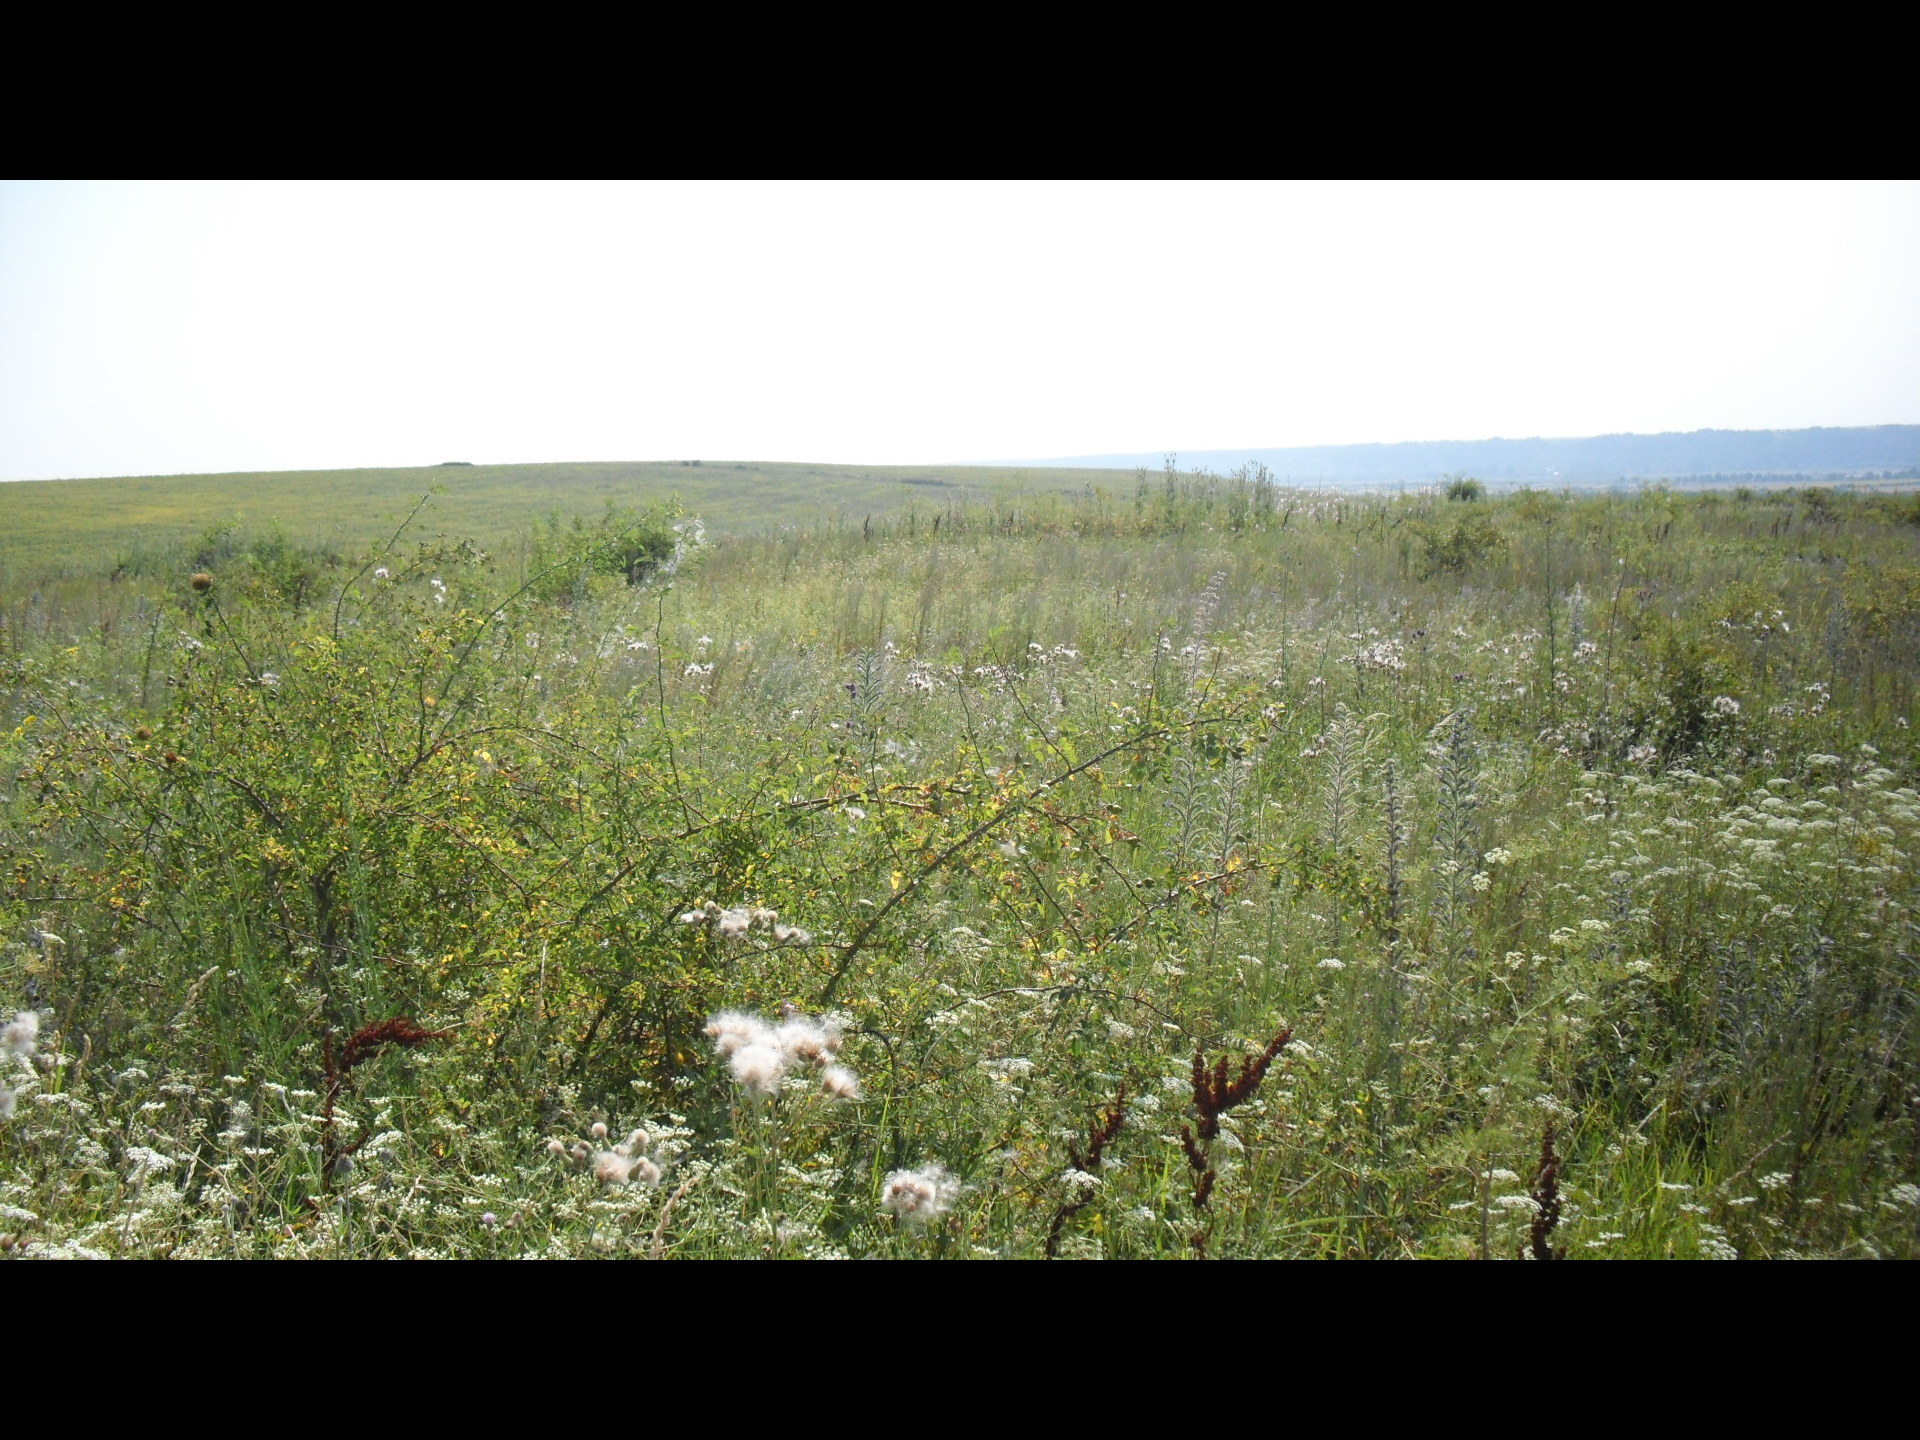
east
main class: Grassland
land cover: Grassland with sparse tree/shrub cover
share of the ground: > 75 %
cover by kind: herbaceous plants 85 %, shrubs 10 %, broadleaved forest trees 5 %
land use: Agriculture (excluding fallow land and kitchen gardens)
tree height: < 5 m
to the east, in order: Grassland with sparse tree/shrub cover; Other bare soil; Grassland with sparse tree/shrub cover
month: July
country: BG
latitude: 43.6433
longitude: 22.8170
